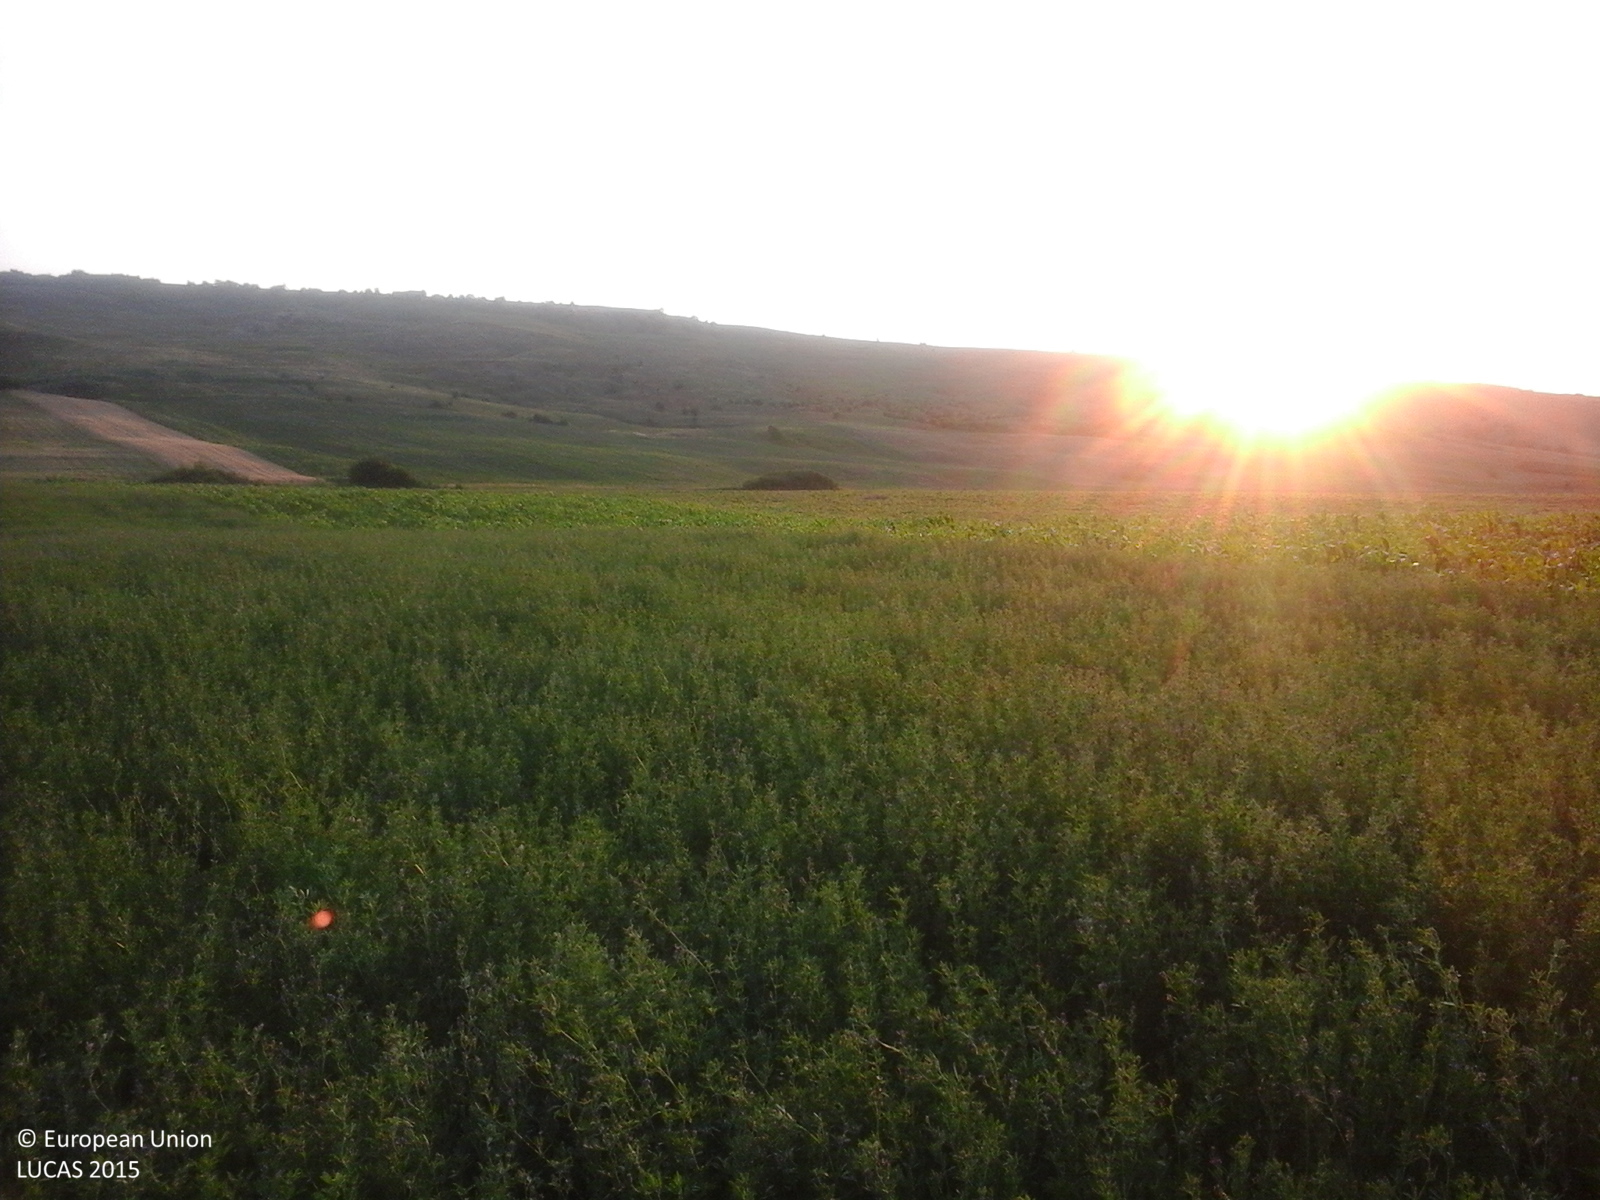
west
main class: Cropland
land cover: Lucerne
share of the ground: > 75 %
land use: Agriculture (excluding fallow land and kitchen gardens)
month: June
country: RO
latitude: 46.8644
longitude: 27.3865
